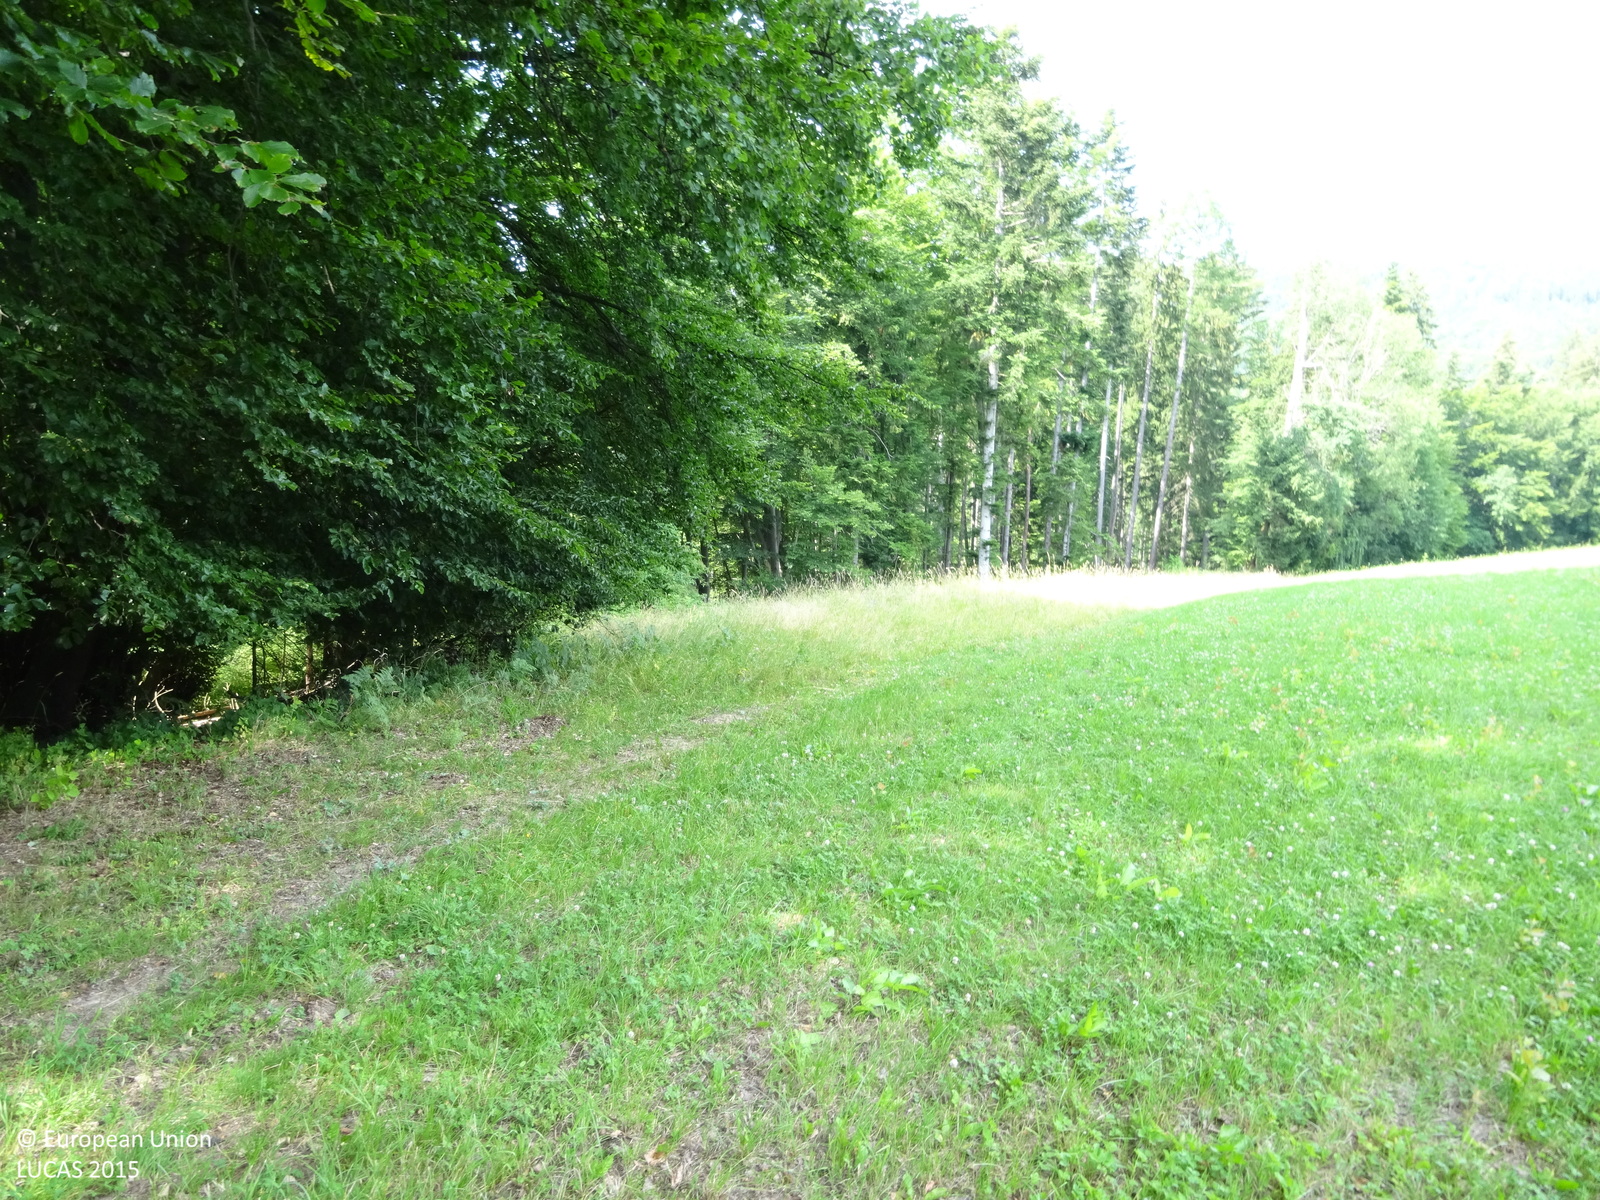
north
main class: Grassland
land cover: Grassland without tree/shrub cover
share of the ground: > 75 %
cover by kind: herbaceous plants 100 %
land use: Agriculture (excluding fallow land and kitchen gardens)
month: July
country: AT
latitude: 47.0740
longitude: 15.1749
